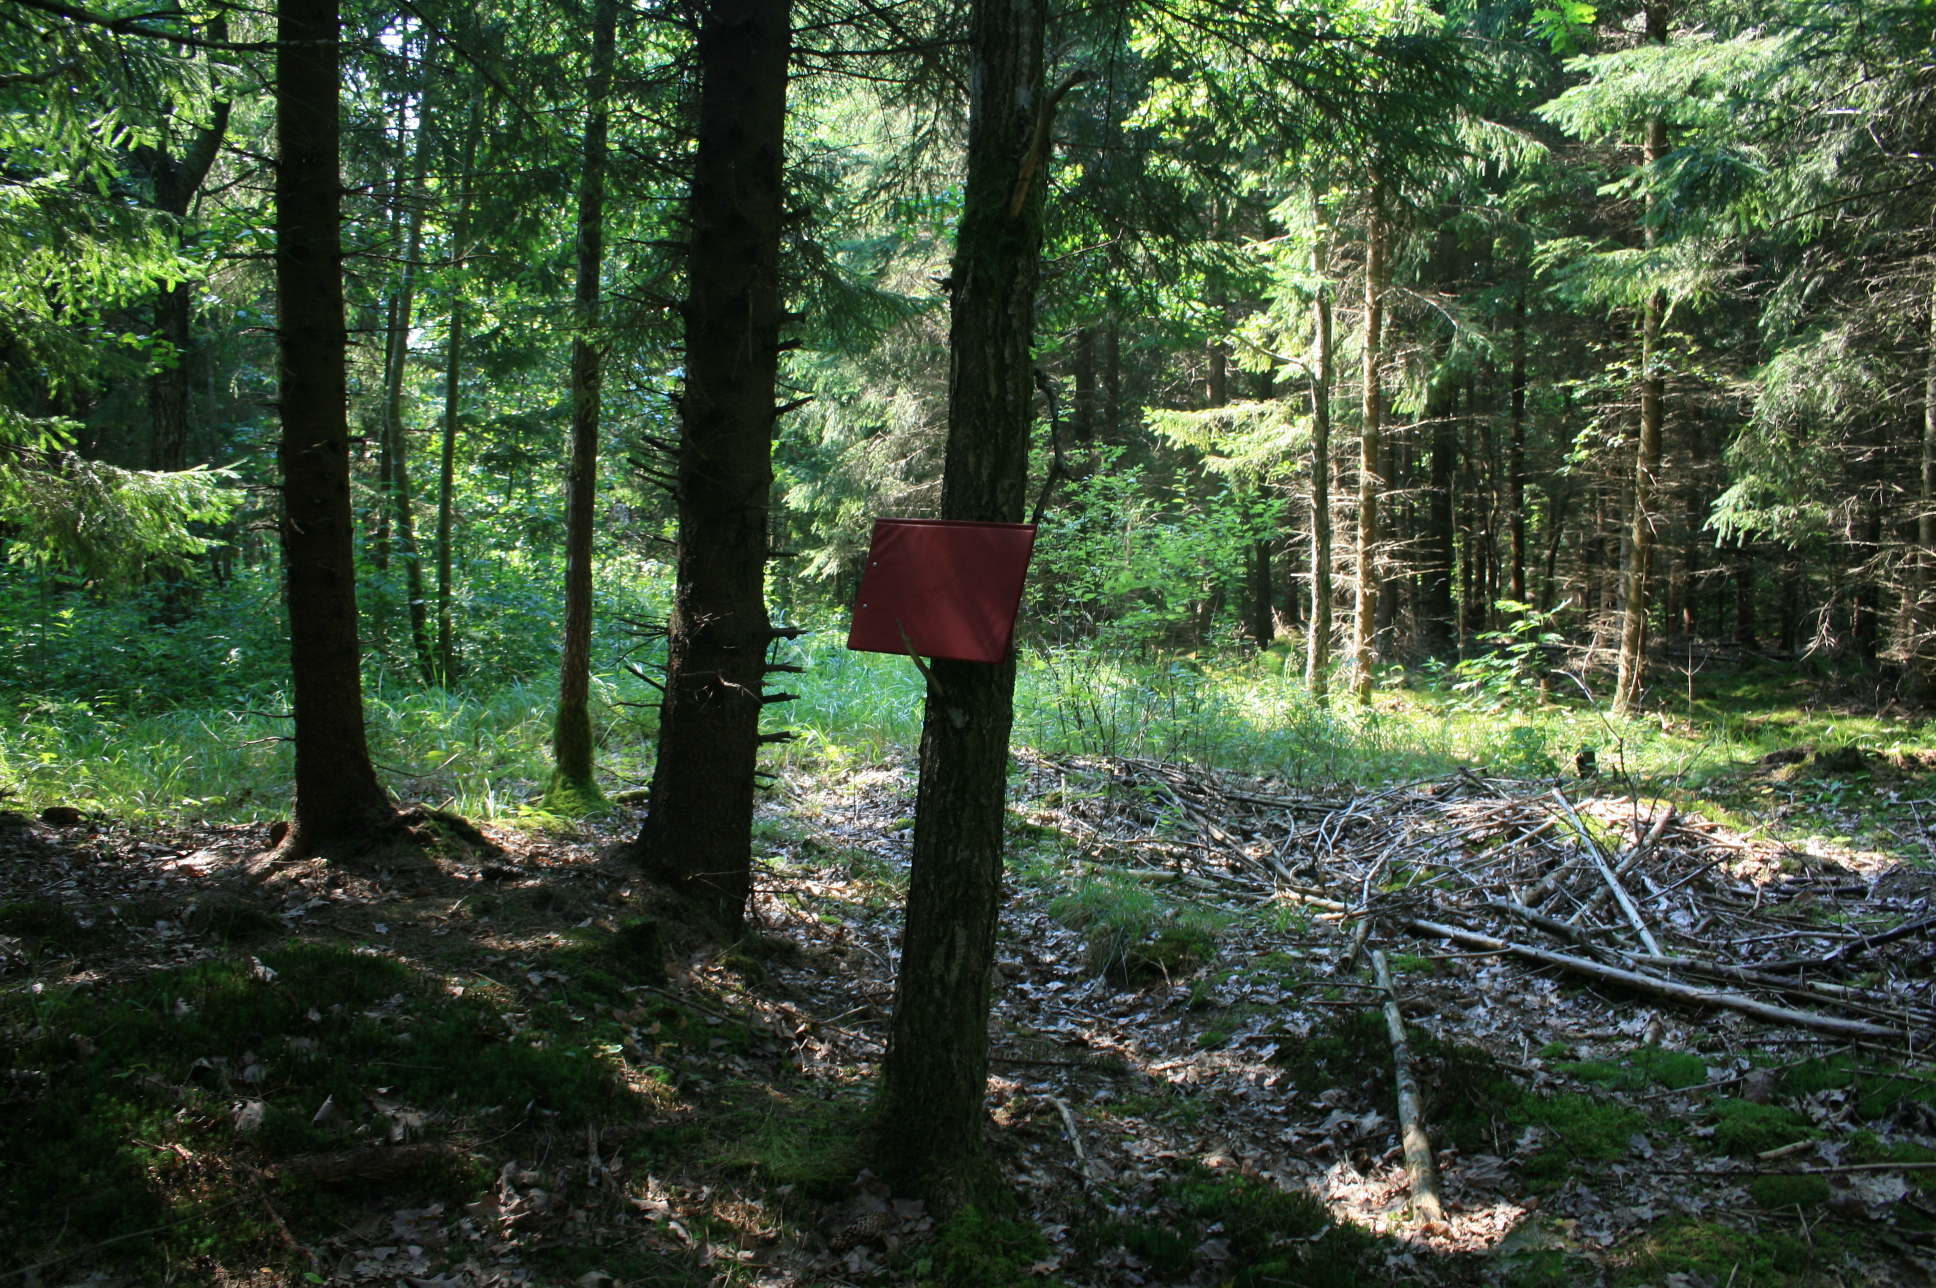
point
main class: Woodland
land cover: Spruce dominated mixed woodland
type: hemiboreal forest and nemoral coniferous forest and mixed broadleaved-coniferous forest
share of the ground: > 75 %
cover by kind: coniferous forest trees 60 %, broadleaved forest trees 25 %, shrubs 5 %, herbaceous plants 5 %, lichens and mosses 5 %
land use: Forestry
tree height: > 5 m
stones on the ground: < 10 %
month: August
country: LT
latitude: 55.5506
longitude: 21.7955
